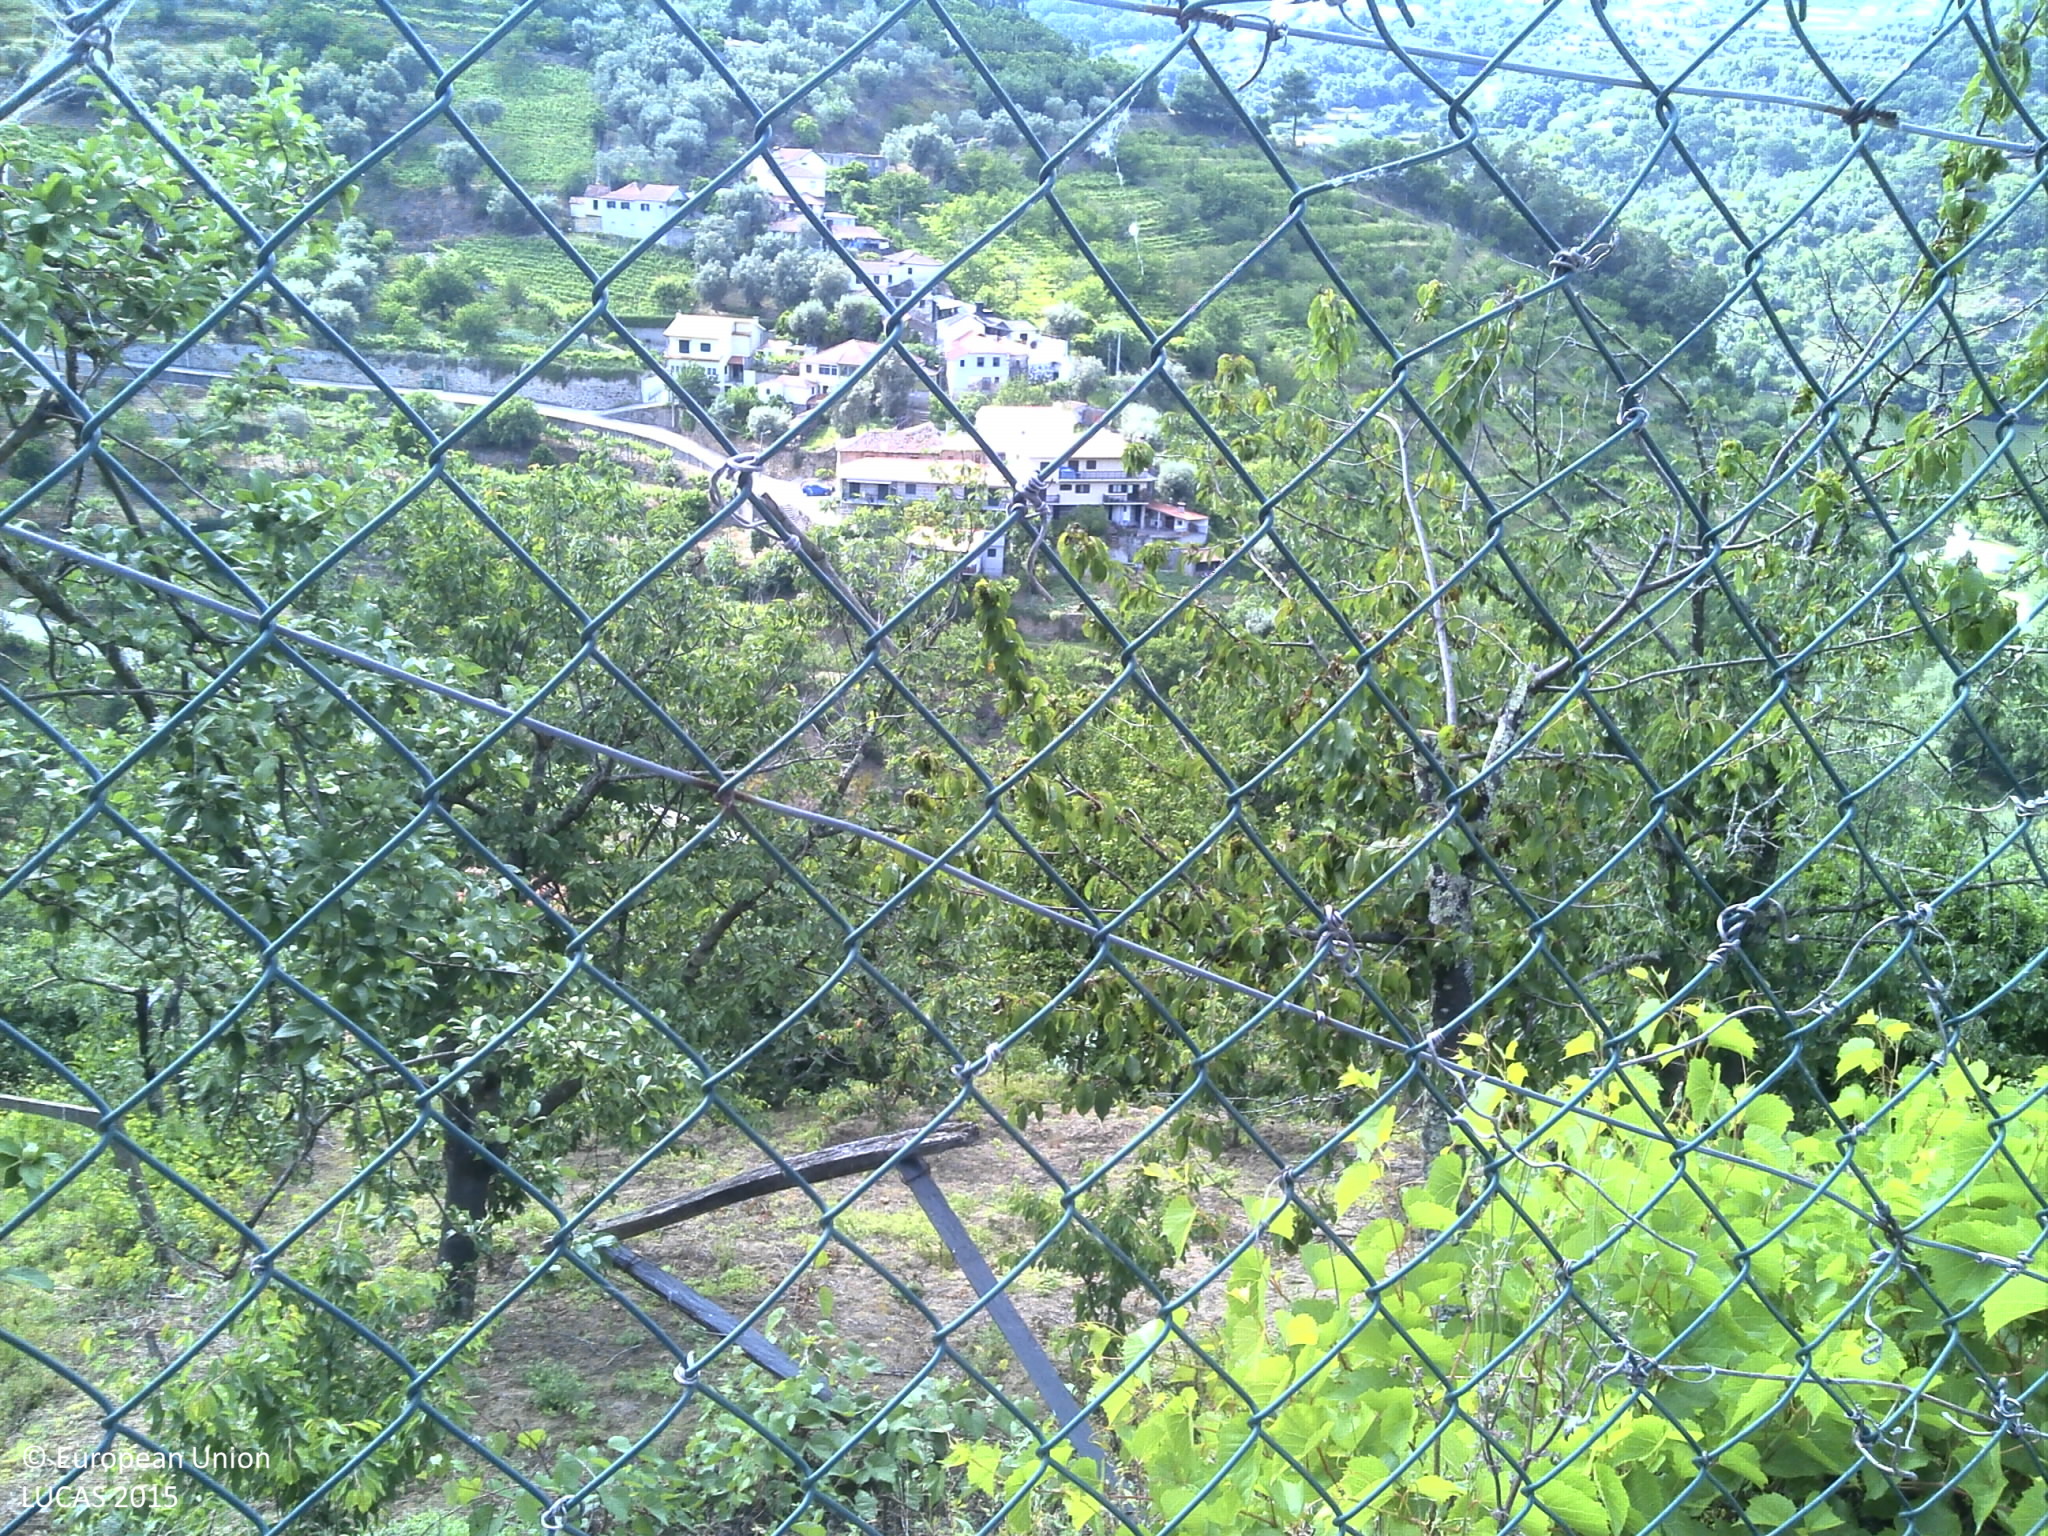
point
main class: Cropland
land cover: Cherry fruit
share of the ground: > 75 %
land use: Agriculture (excluding fallow land and kitchen gardens)
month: May
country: PT
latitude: 41.1155
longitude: -7.9127
